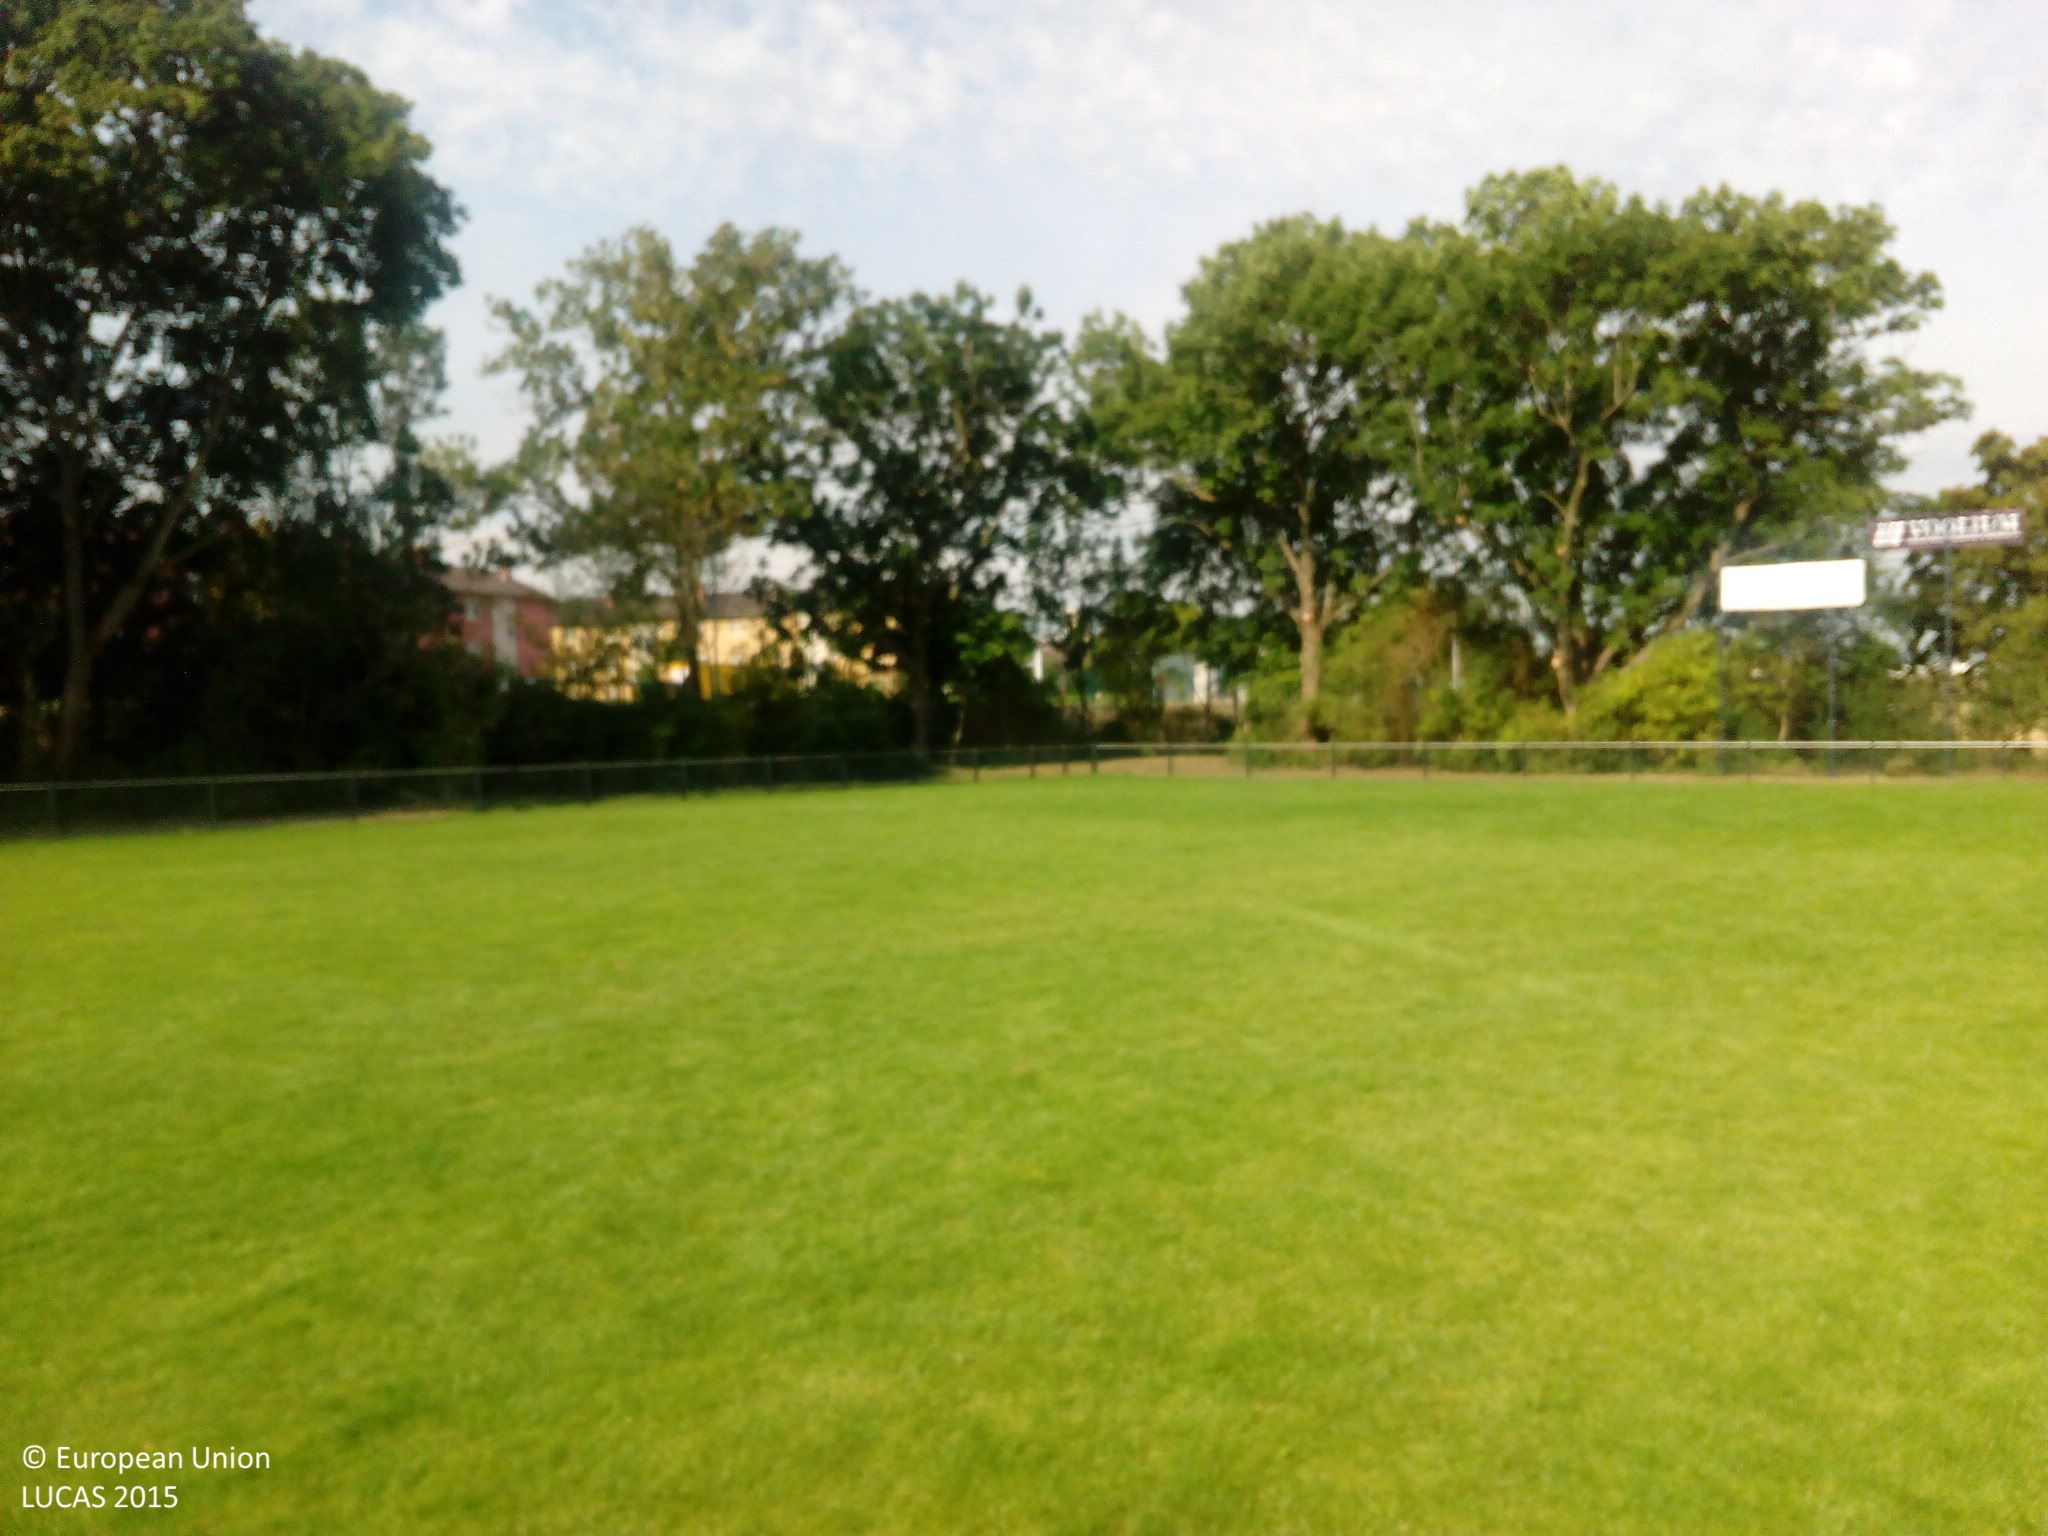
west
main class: Grassland
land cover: Grassland without tree/shrub cover
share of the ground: > 75 %
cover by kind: herbaceous plants 95 %, unconsolidated bare surface 5 %
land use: Sport
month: August
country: DE
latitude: 49.4736
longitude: 8.5514
